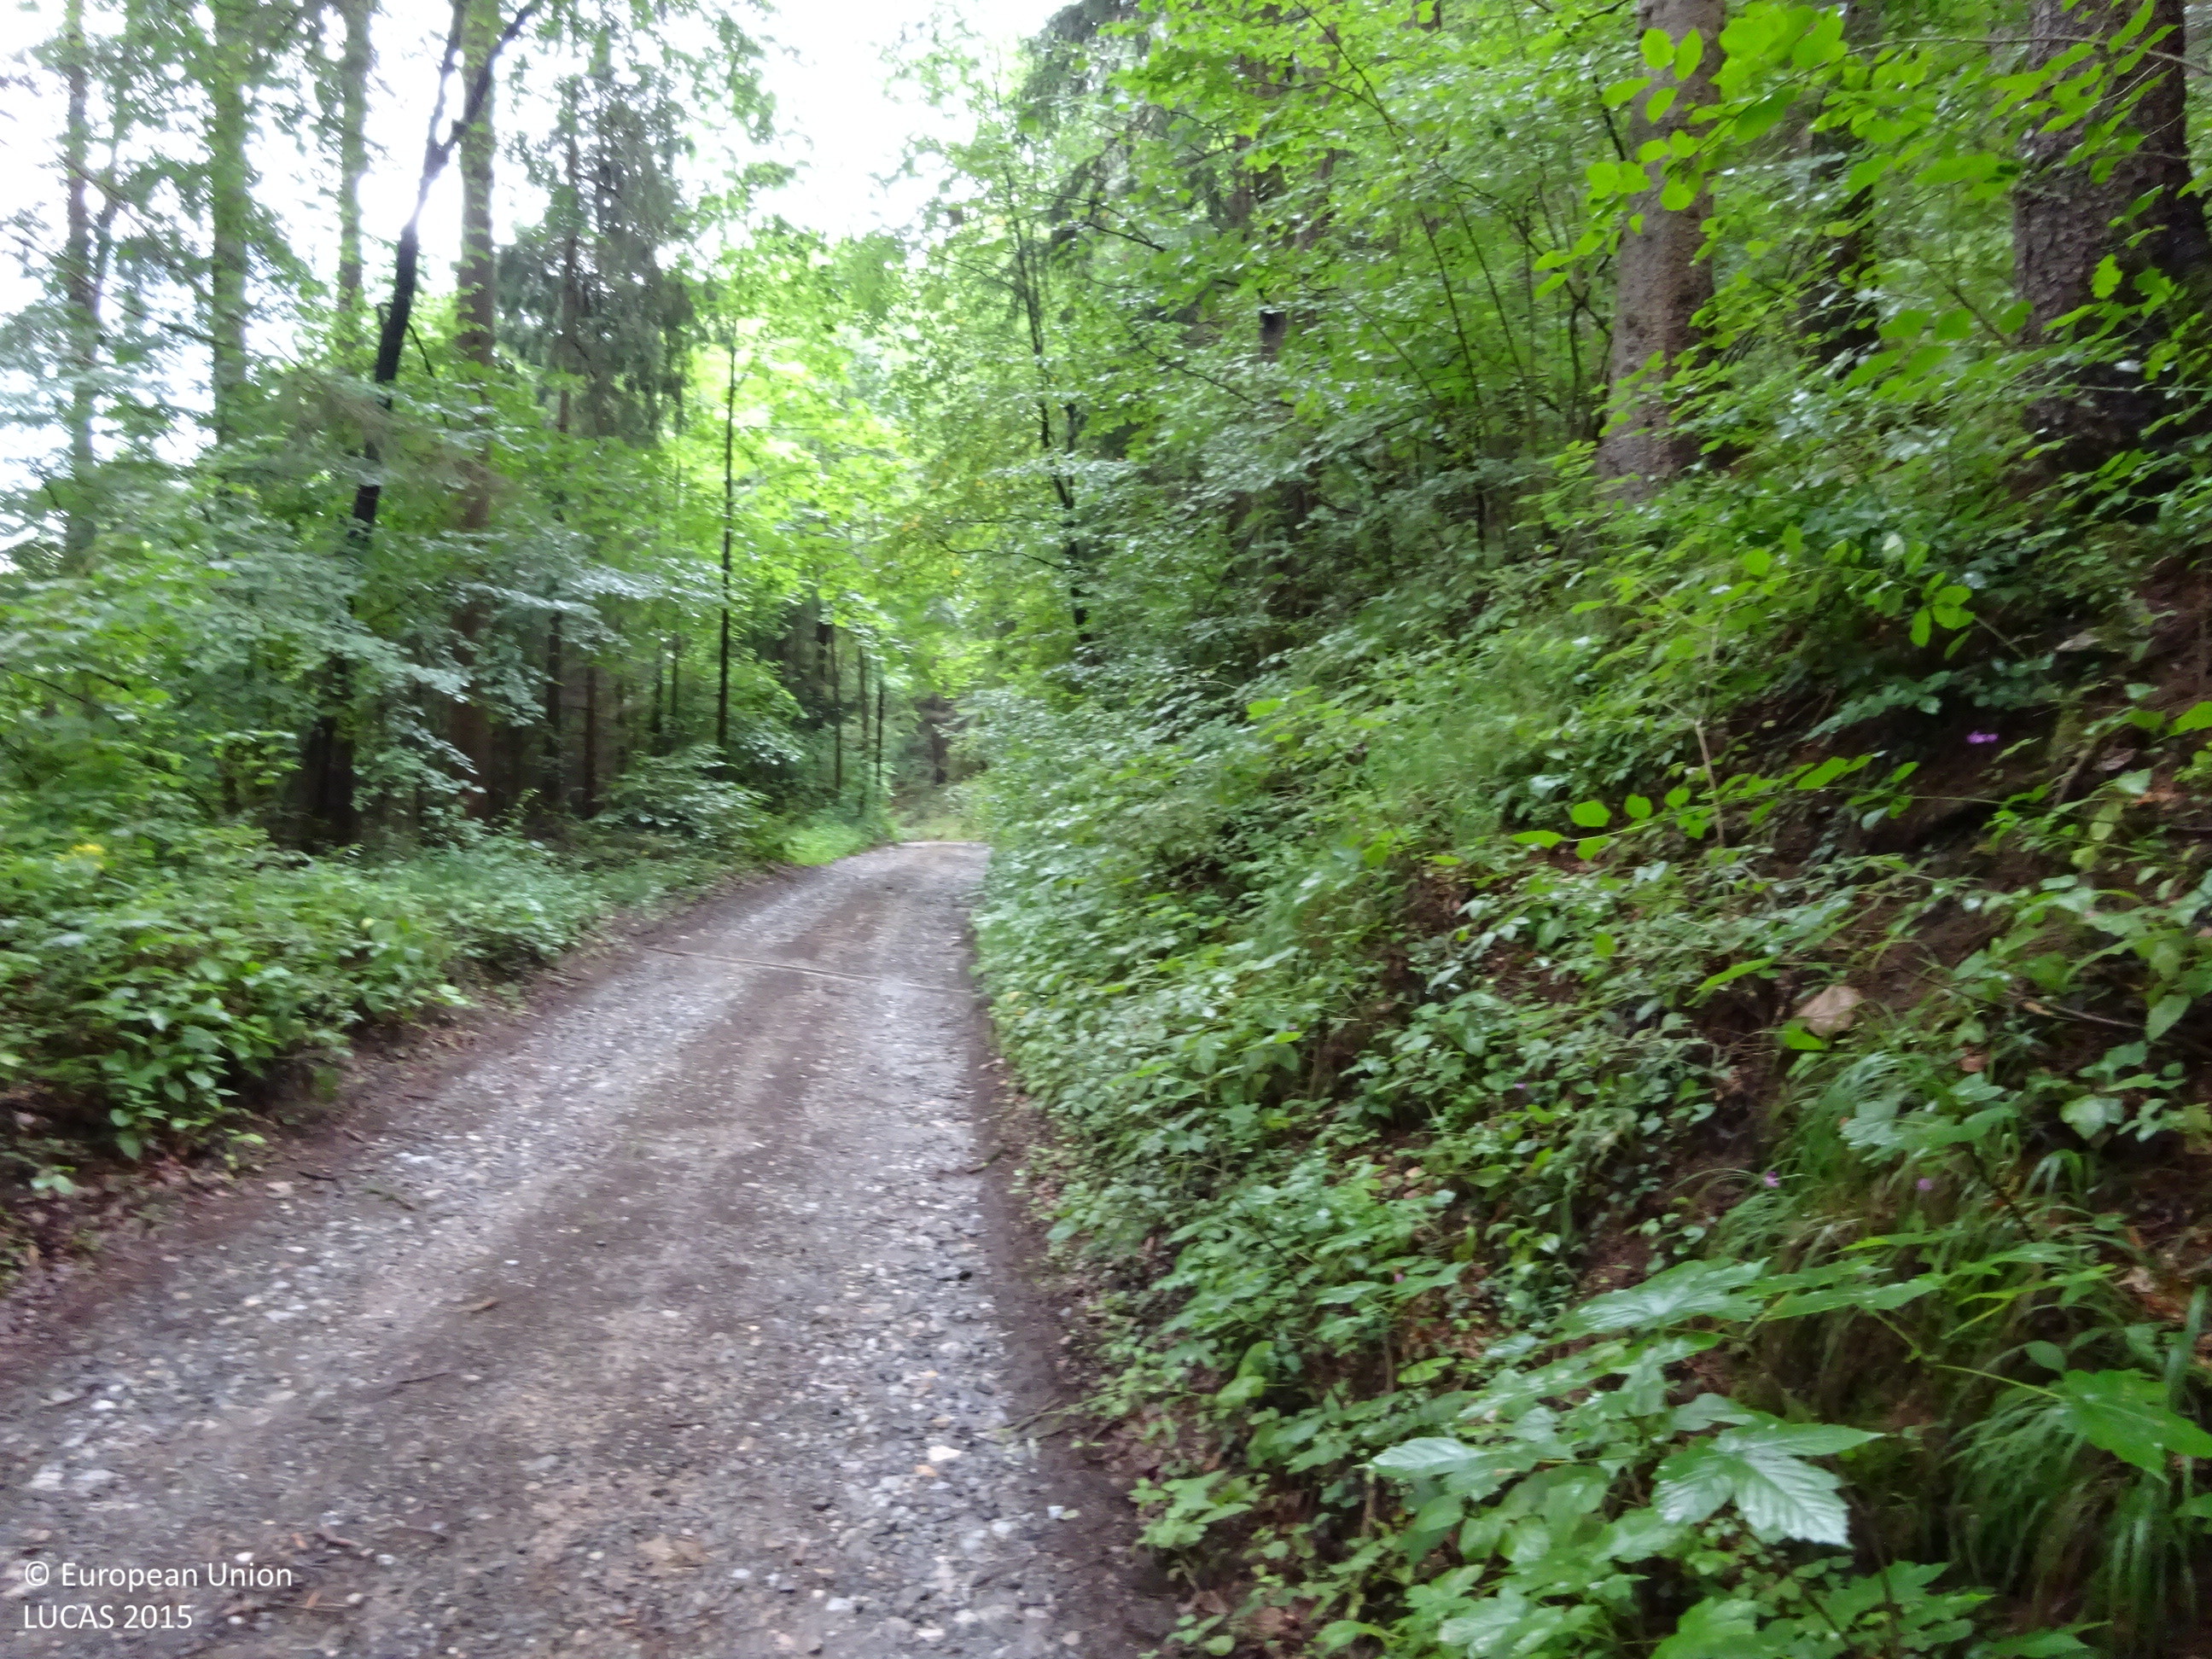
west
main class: Woodland
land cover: Spruce dominated mixed woodland
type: mountainous beech forest
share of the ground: > 75 %
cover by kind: coniferous forest trees 55 %, broadleaved forest trees 35 %, herbaceous plants 5 %, lichens and mosses 5 %
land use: Forestry
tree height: > 5 m
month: July
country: AT
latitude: 47.3164
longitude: 15.3846
